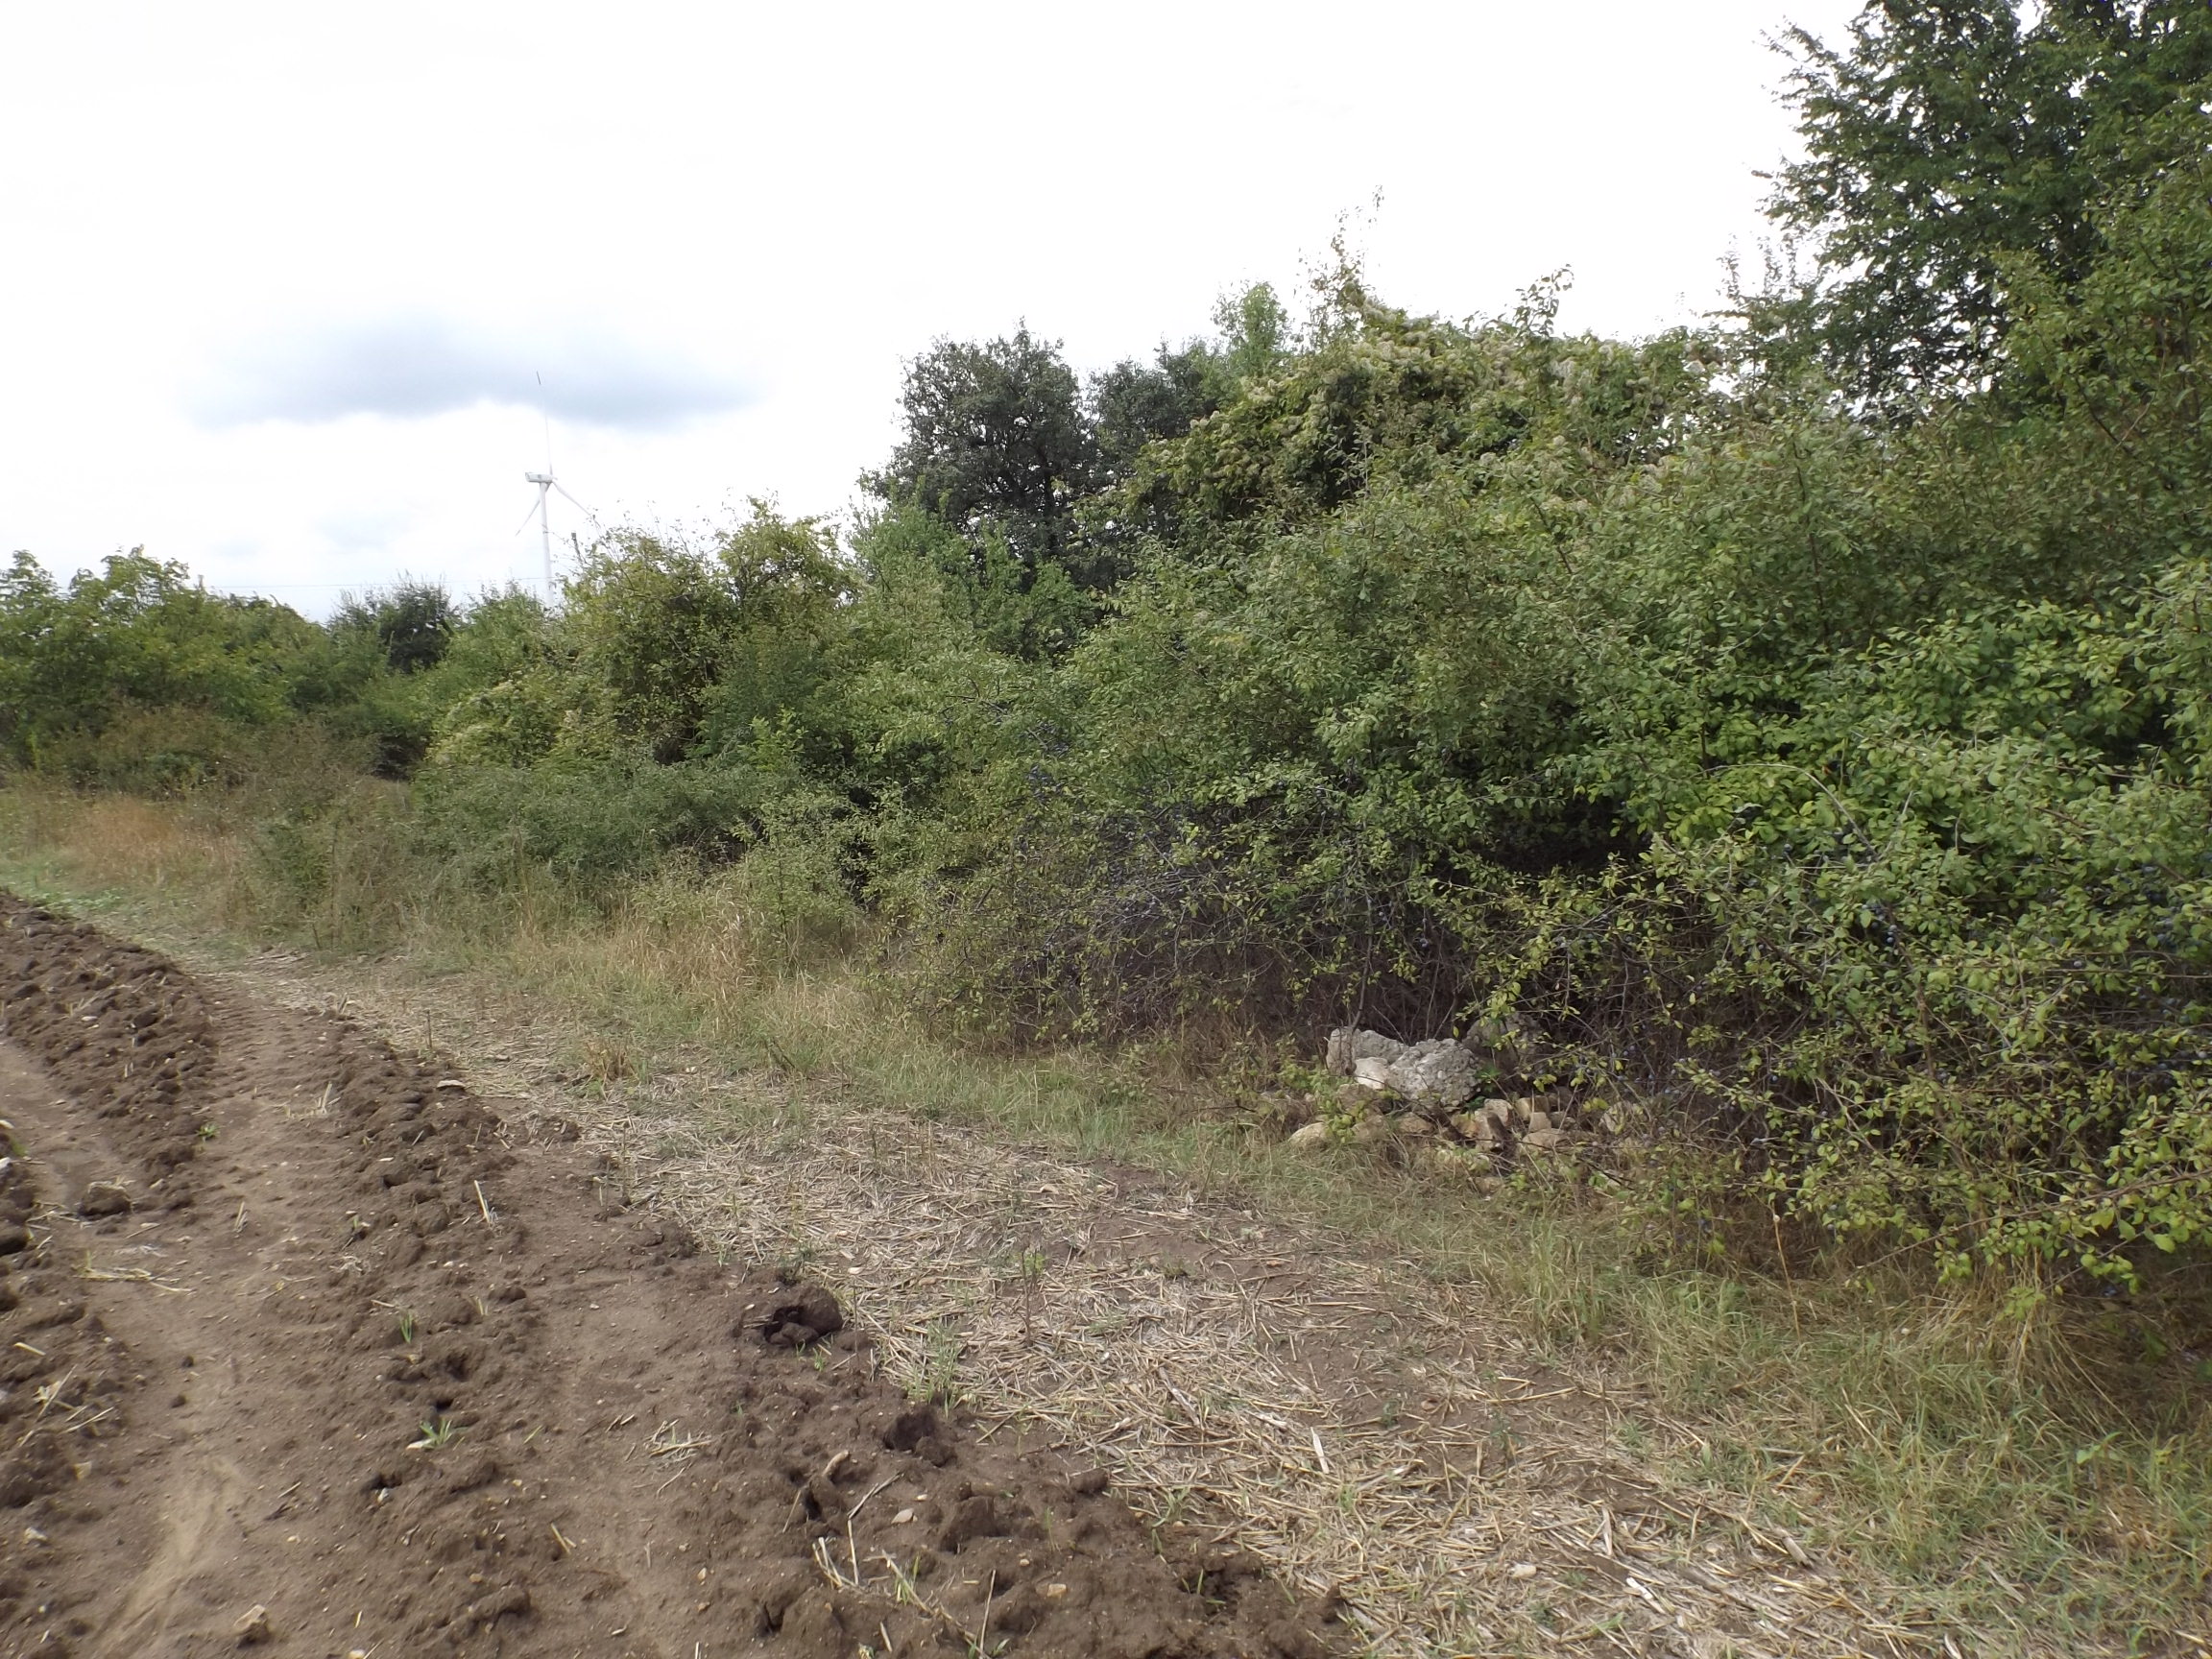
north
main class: Cropland
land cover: Common wheat
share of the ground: < 10 %
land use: Agriculture (excluding fallow land and kitchen gardens)
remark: Harvested field
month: August
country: BG
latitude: 43.3497
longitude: 27.5884
